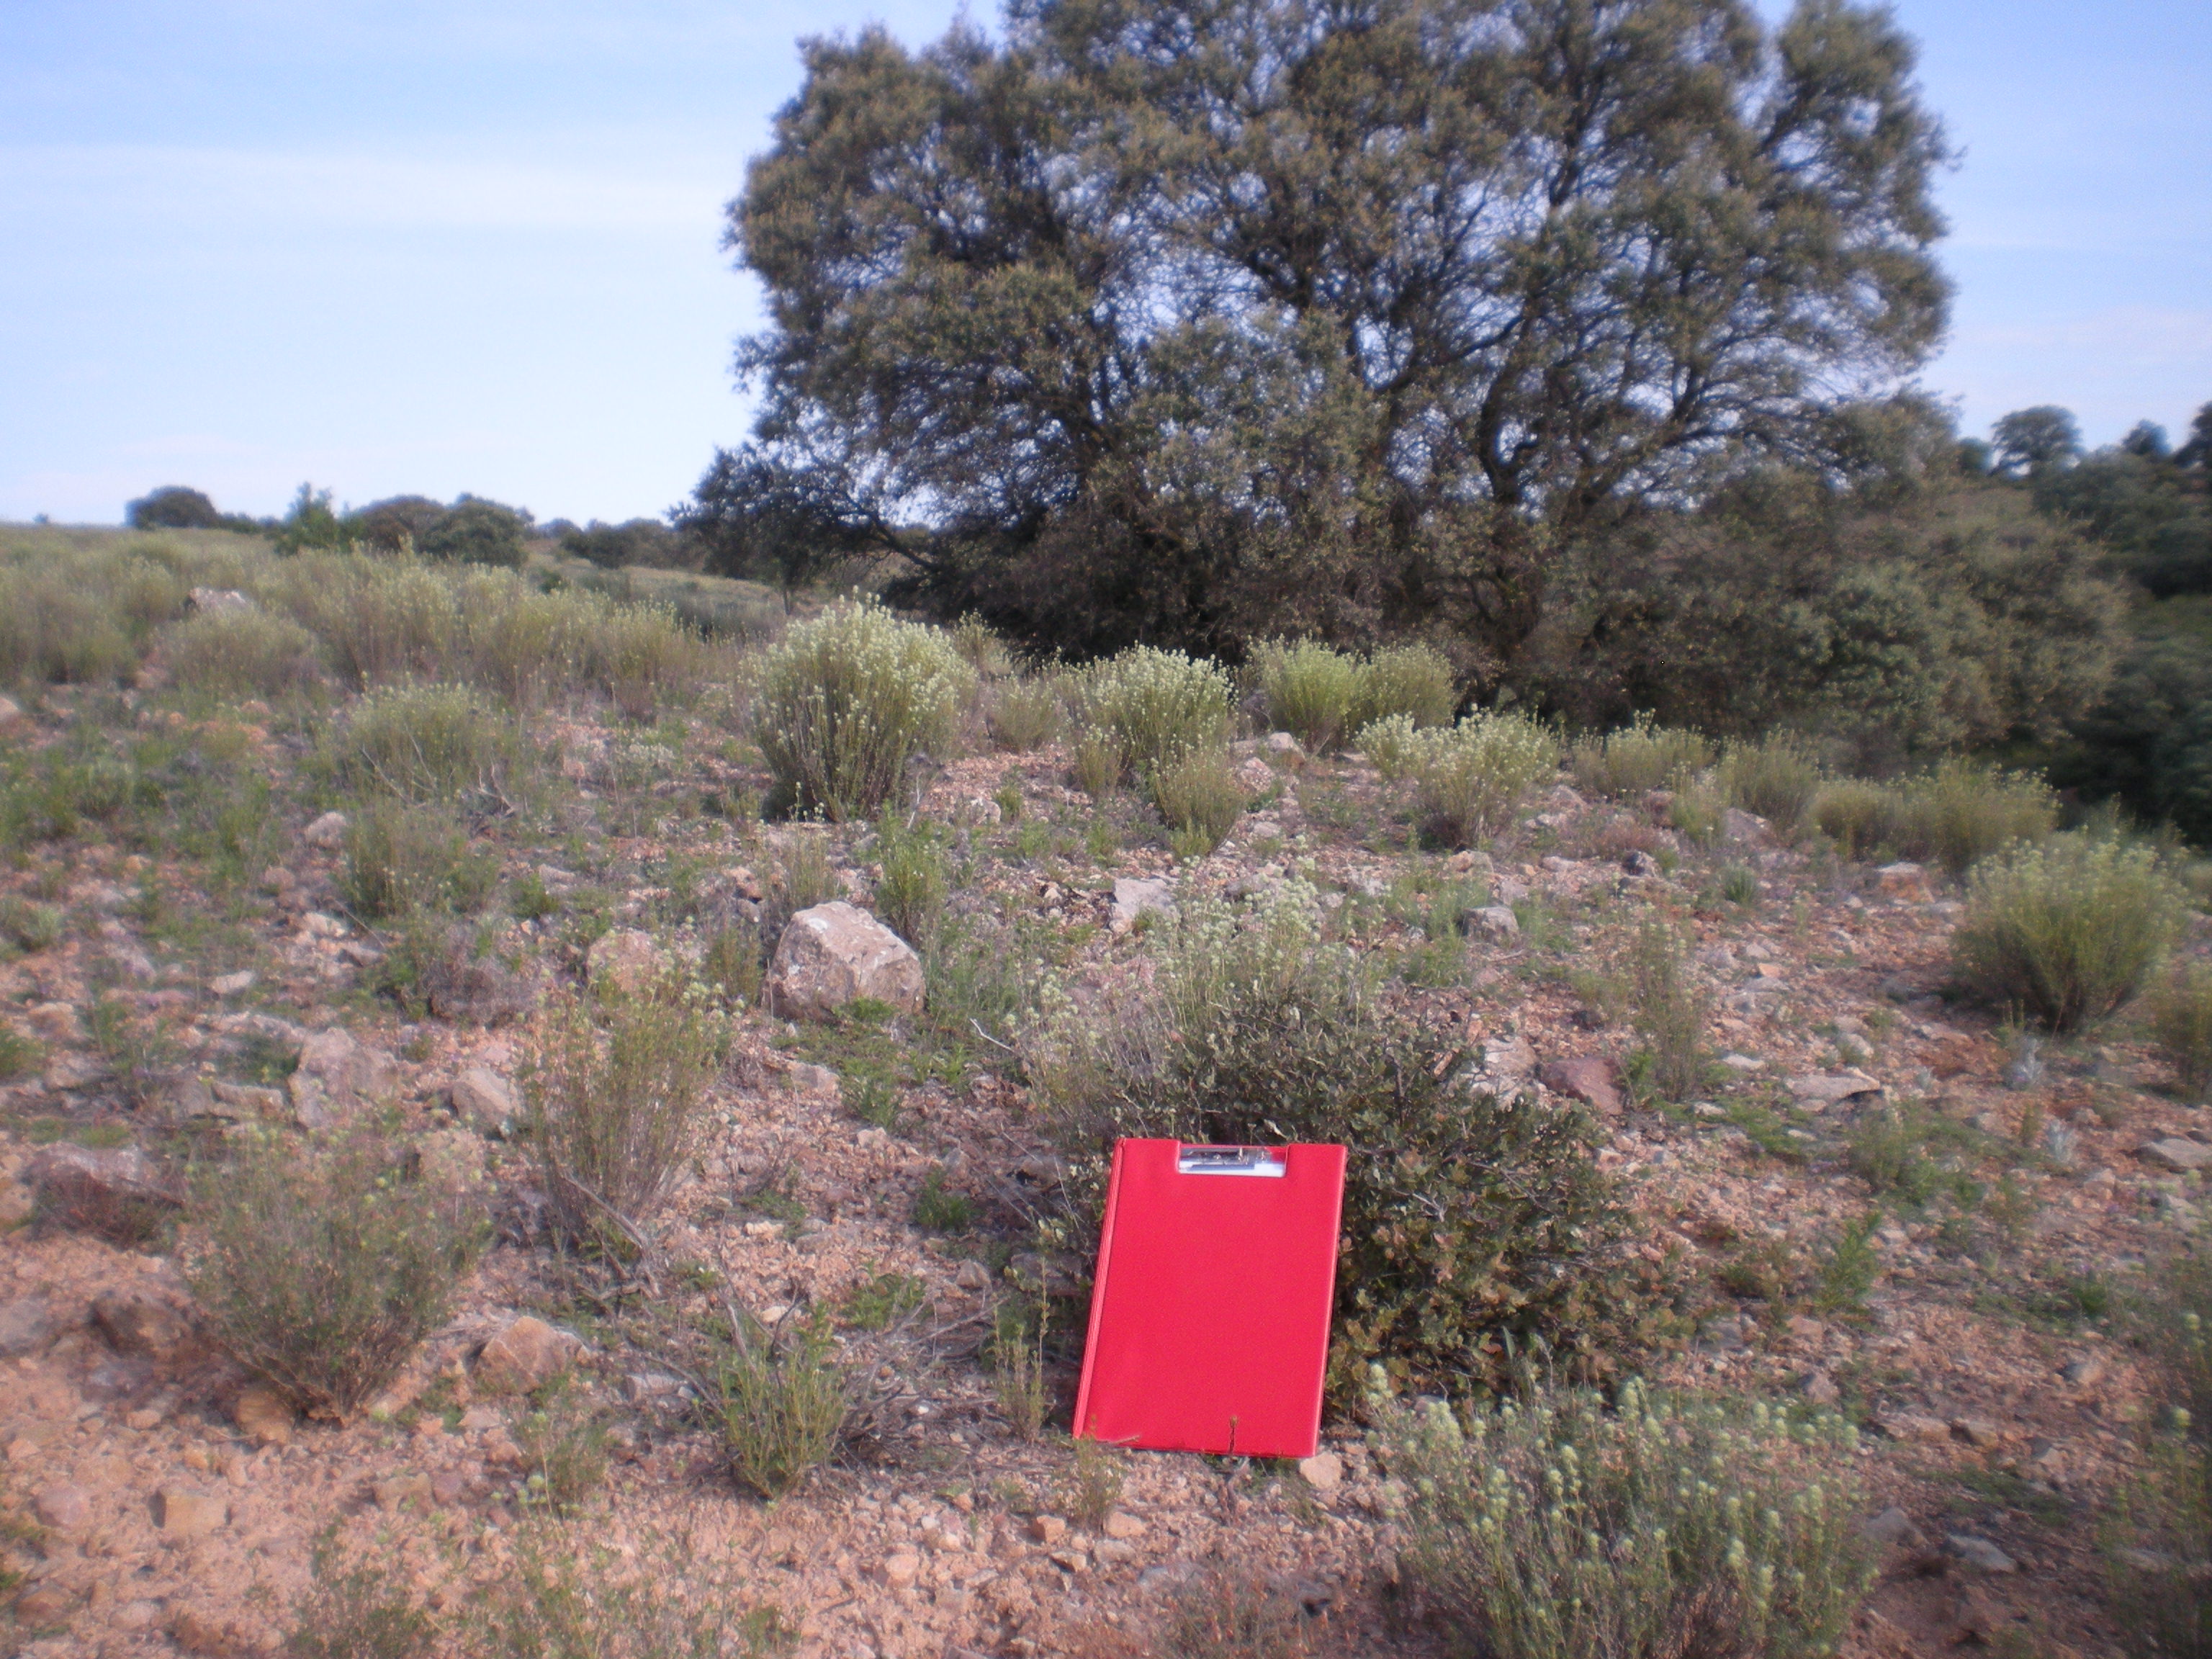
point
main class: Shrubland
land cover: Shrubland with sparse tree cover
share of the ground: 25 - 50 %
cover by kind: unconsolidated bare surface 40 %, herbaceous plants 35 %, shrubs 20 %, broadleaved forest trees 5 %
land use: Semi-natural and natural areas not in use
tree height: < 5 m
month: May
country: ES
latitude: 39.0018
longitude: -2.9541
